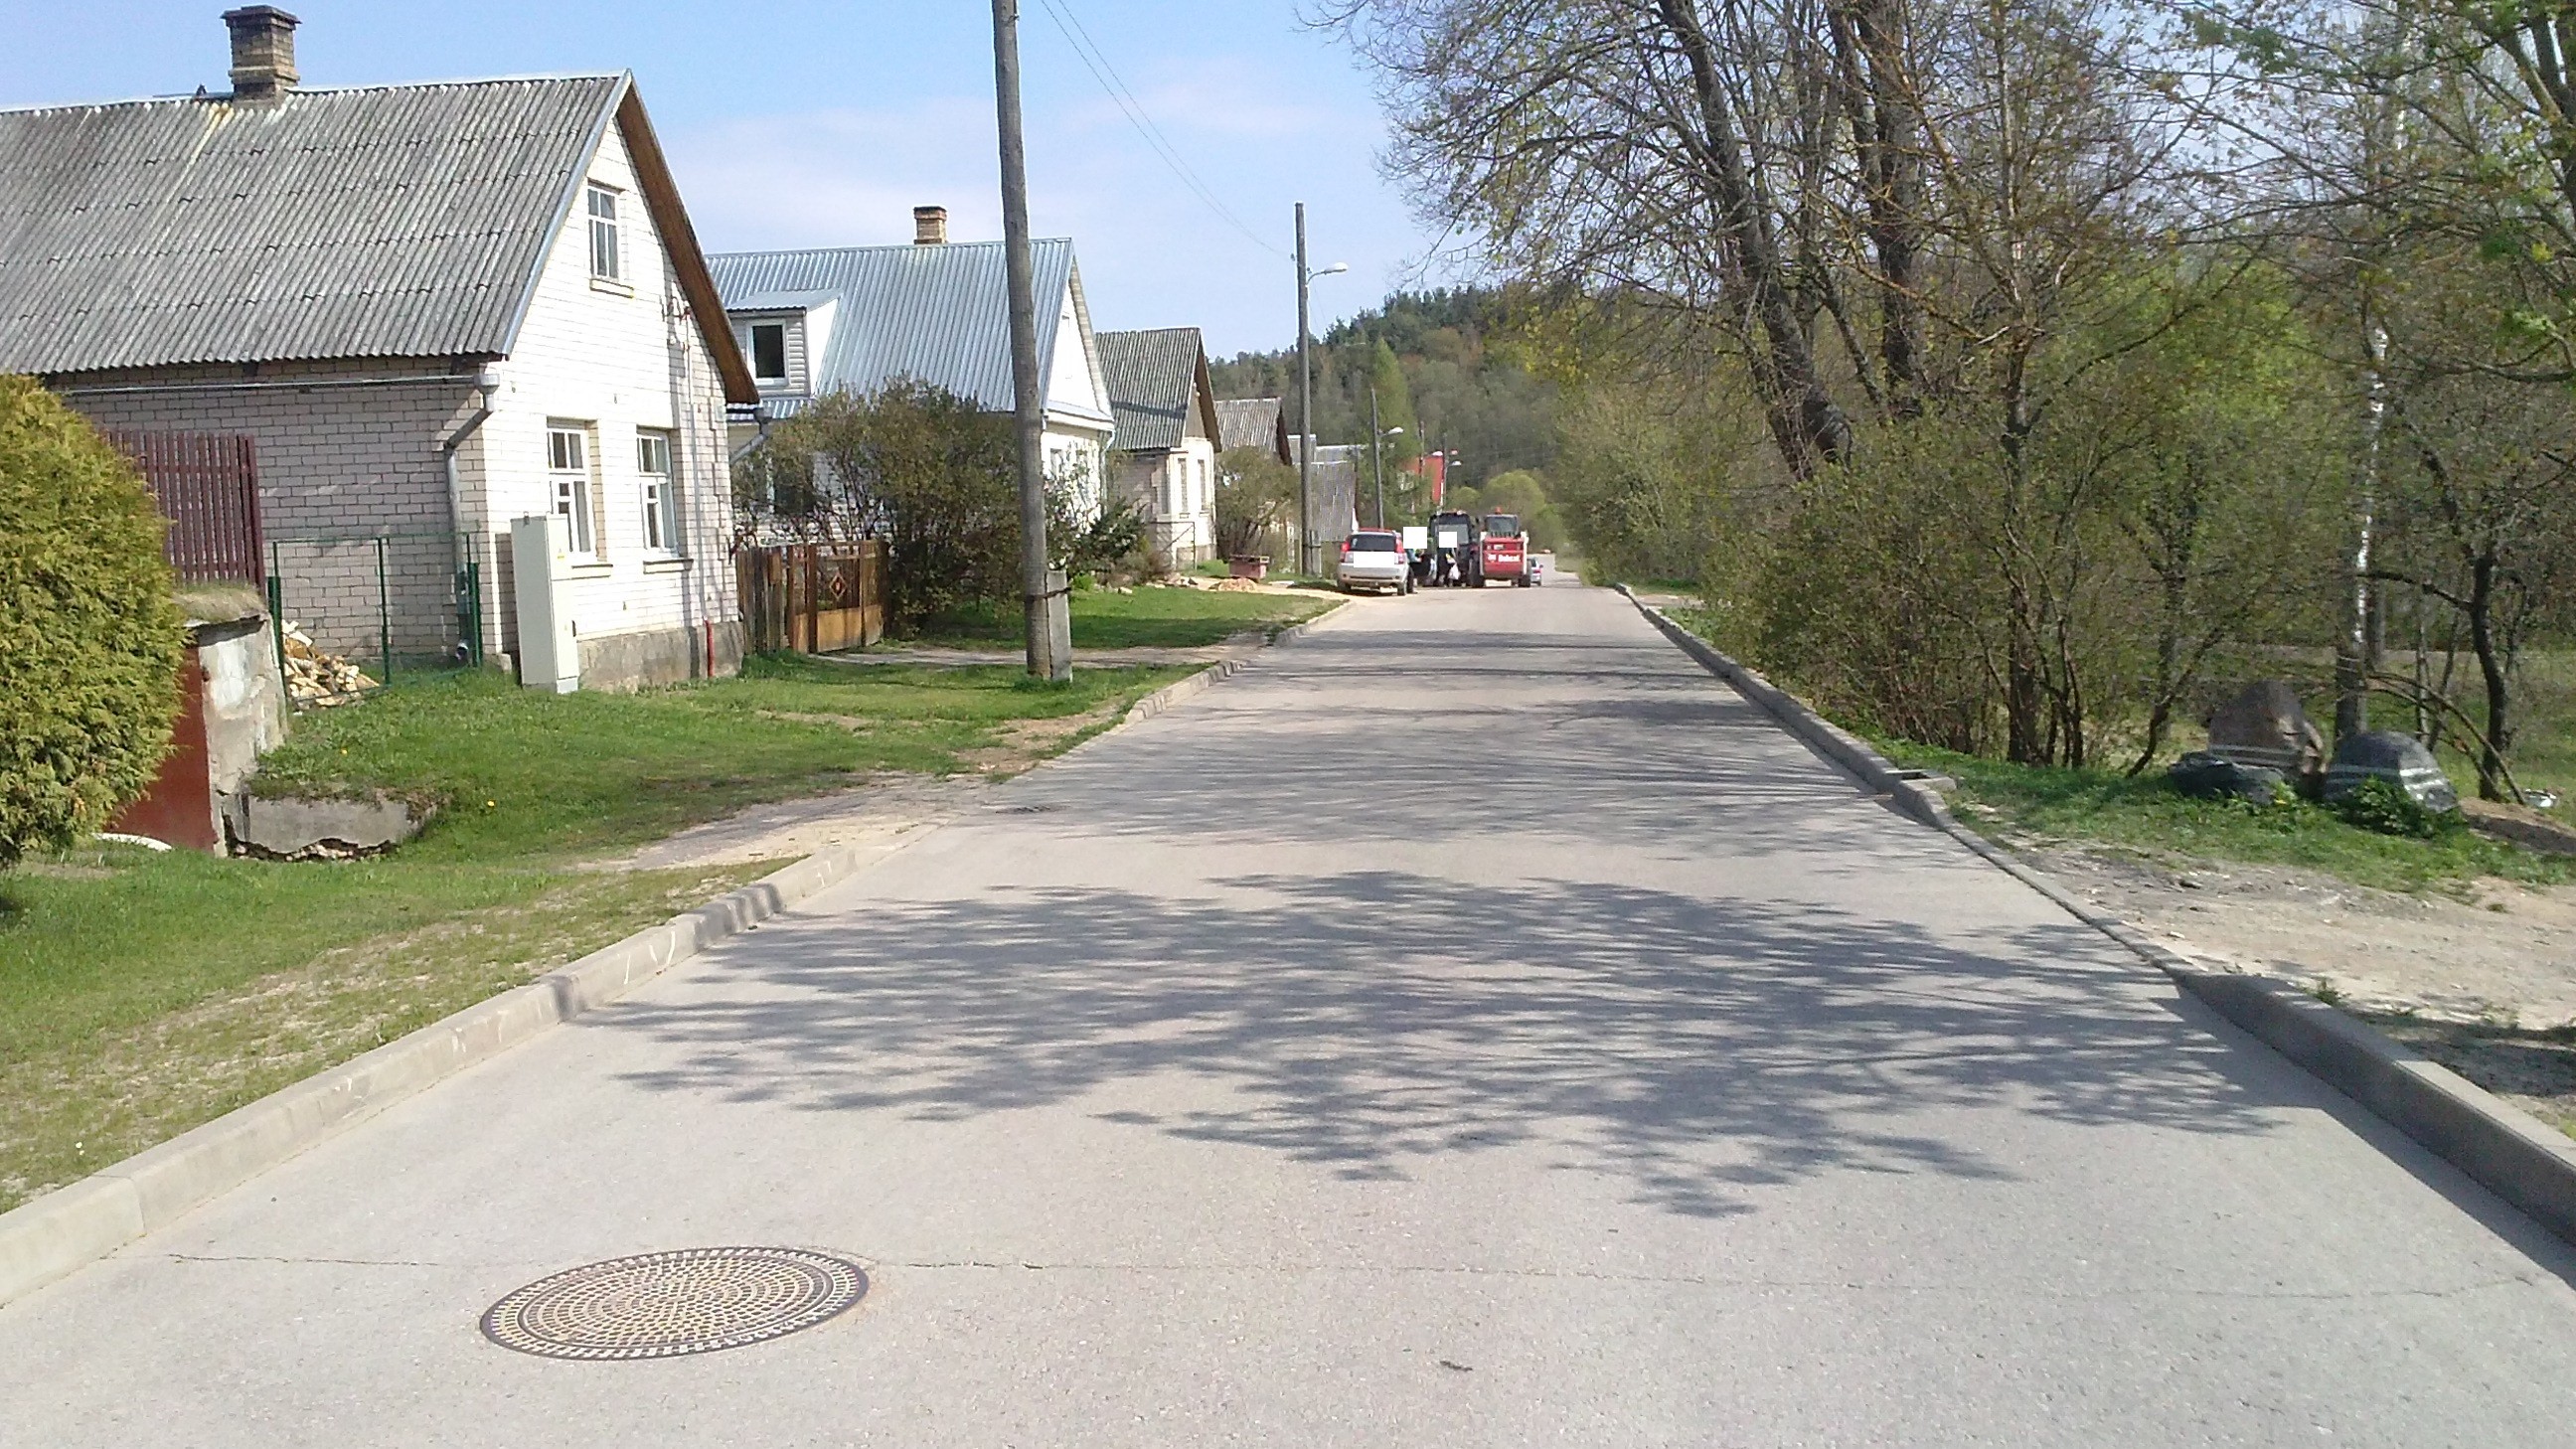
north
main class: Cropland
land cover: Apple fruit
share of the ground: > 75 %
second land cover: Grassland without tree/shrub cover
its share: > 75 %
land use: Kitchen garden
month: May
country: LV
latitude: 55.9015
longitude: 27.1730
